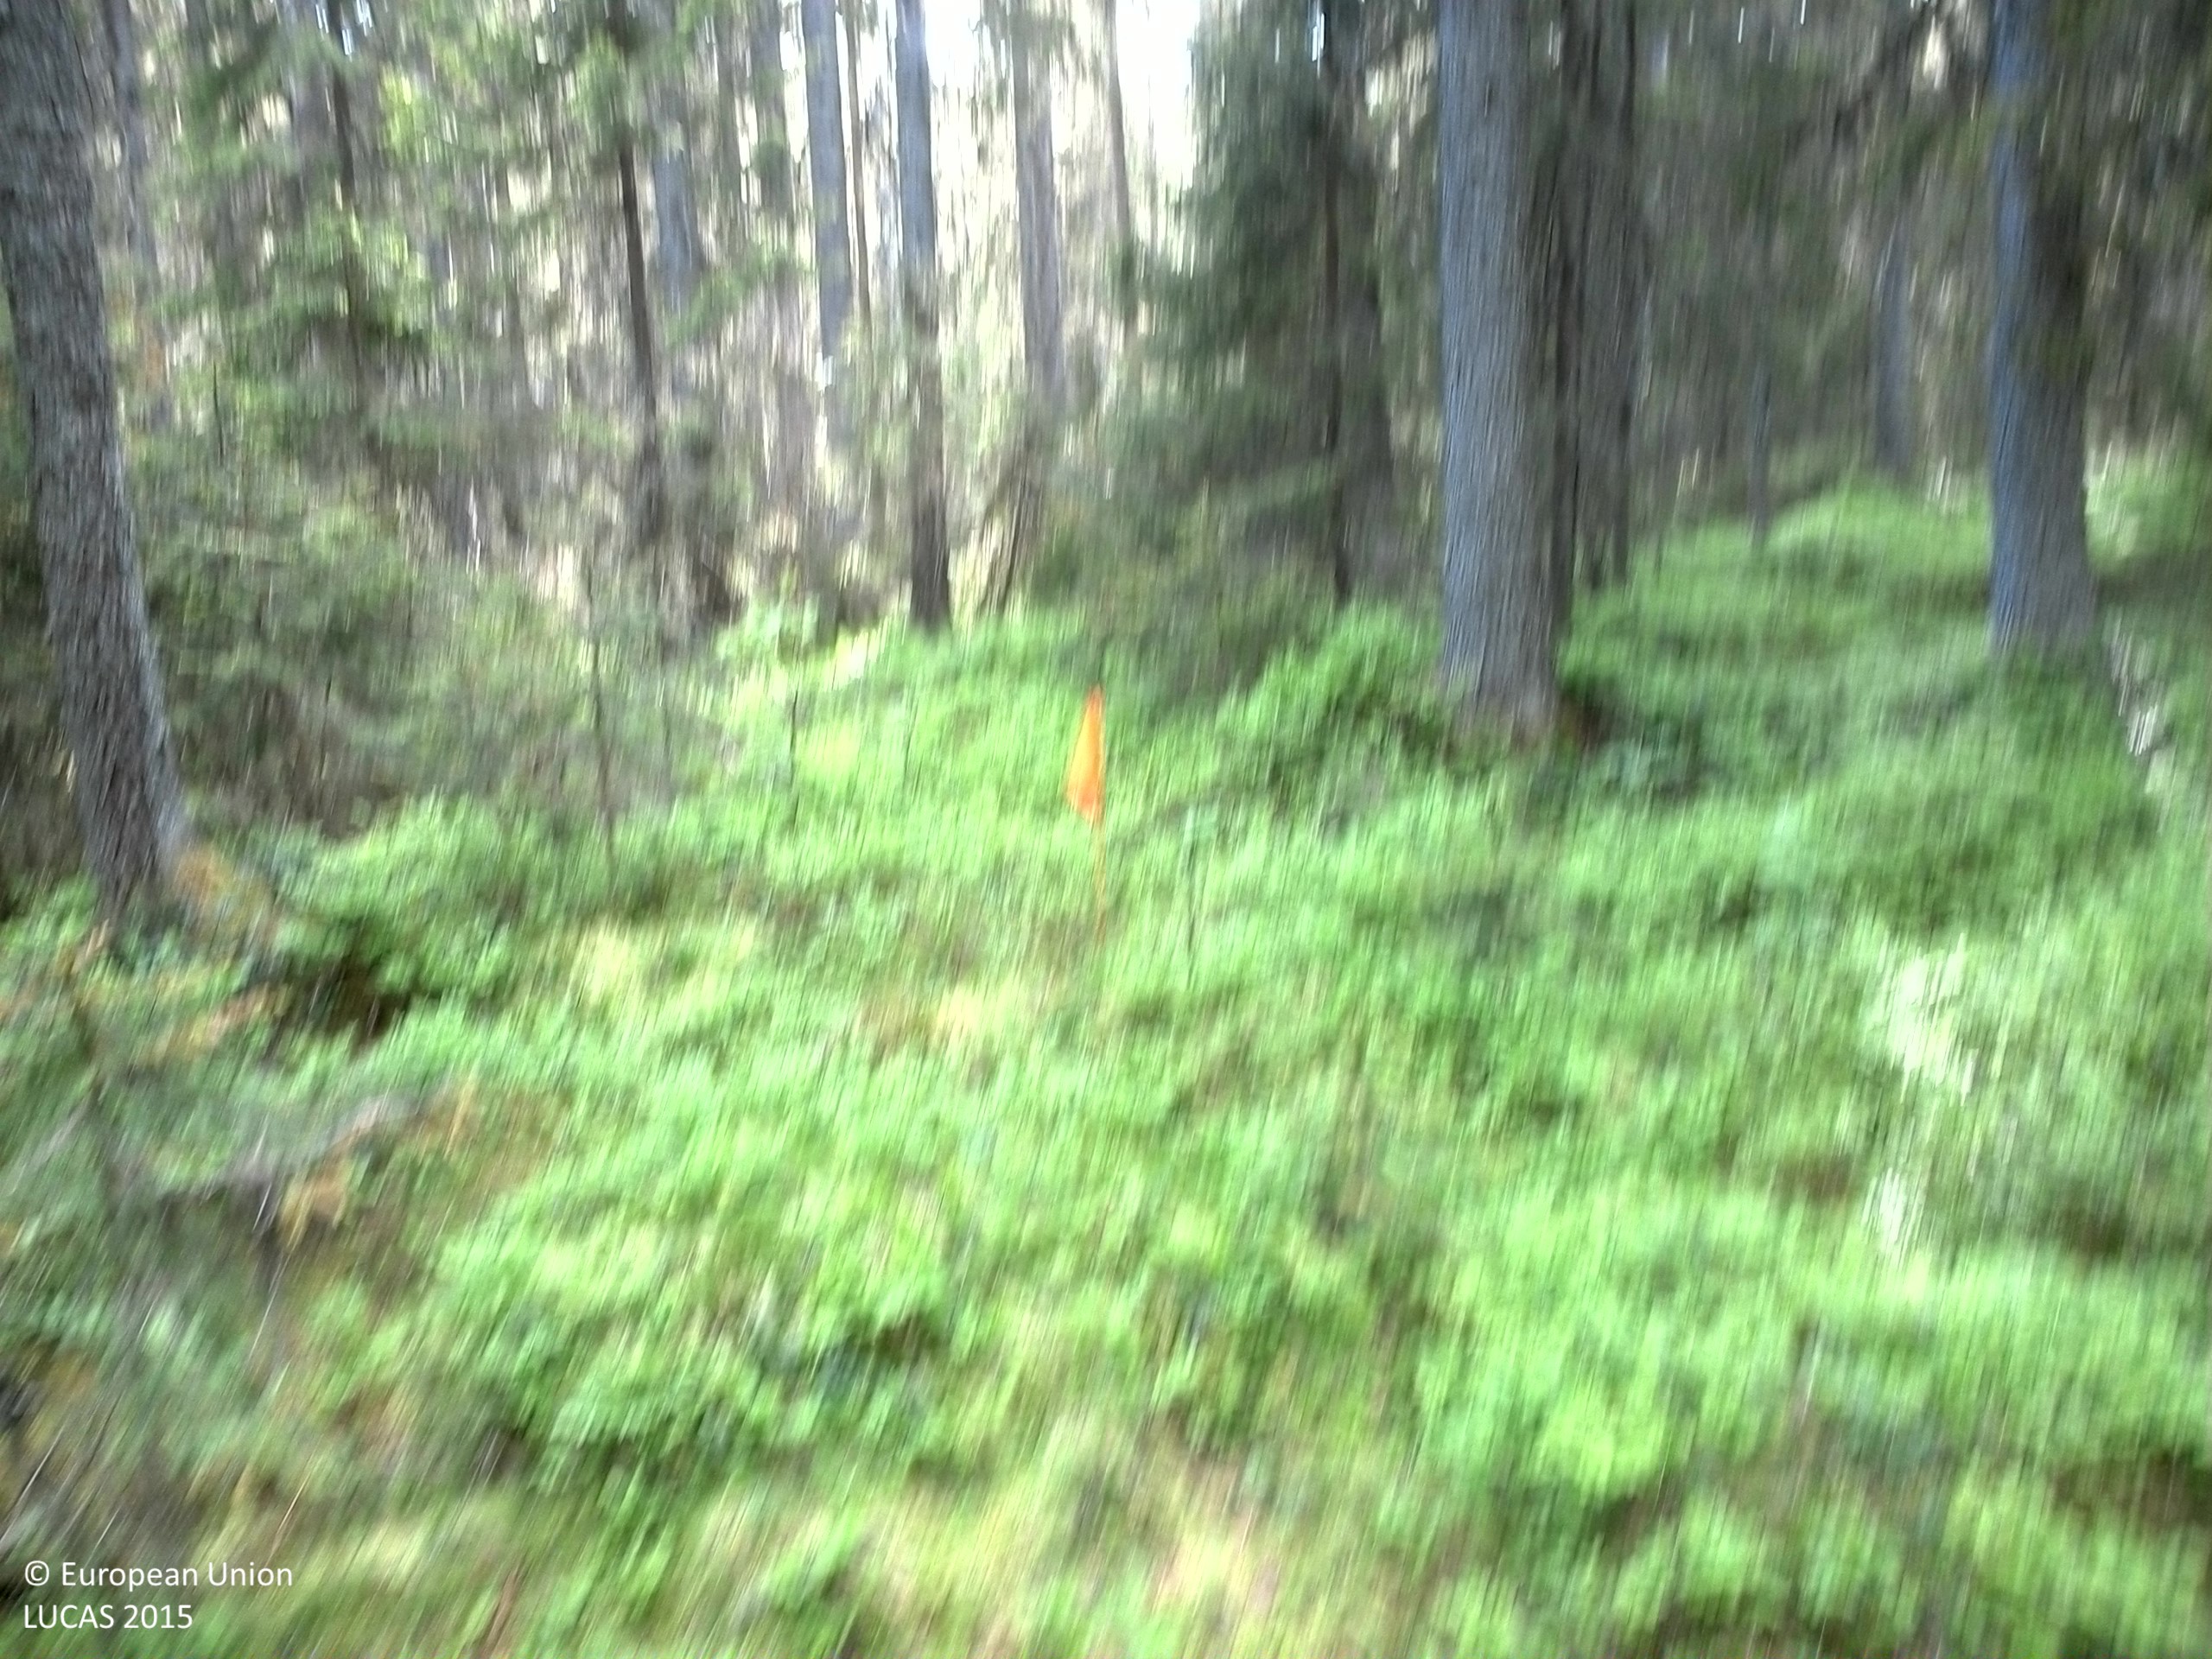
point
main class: Woodland
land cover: Spruce dominated coniferous woodland
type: boreal forest
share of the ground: 50 - 75 %
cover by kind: coniferous forest trees 60 %, shrubs 30 %, broadleaved forest trees 10 %
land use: Forestry
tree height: > 5 m
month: June
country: SE
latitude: 63.3910
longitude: 18.1205
